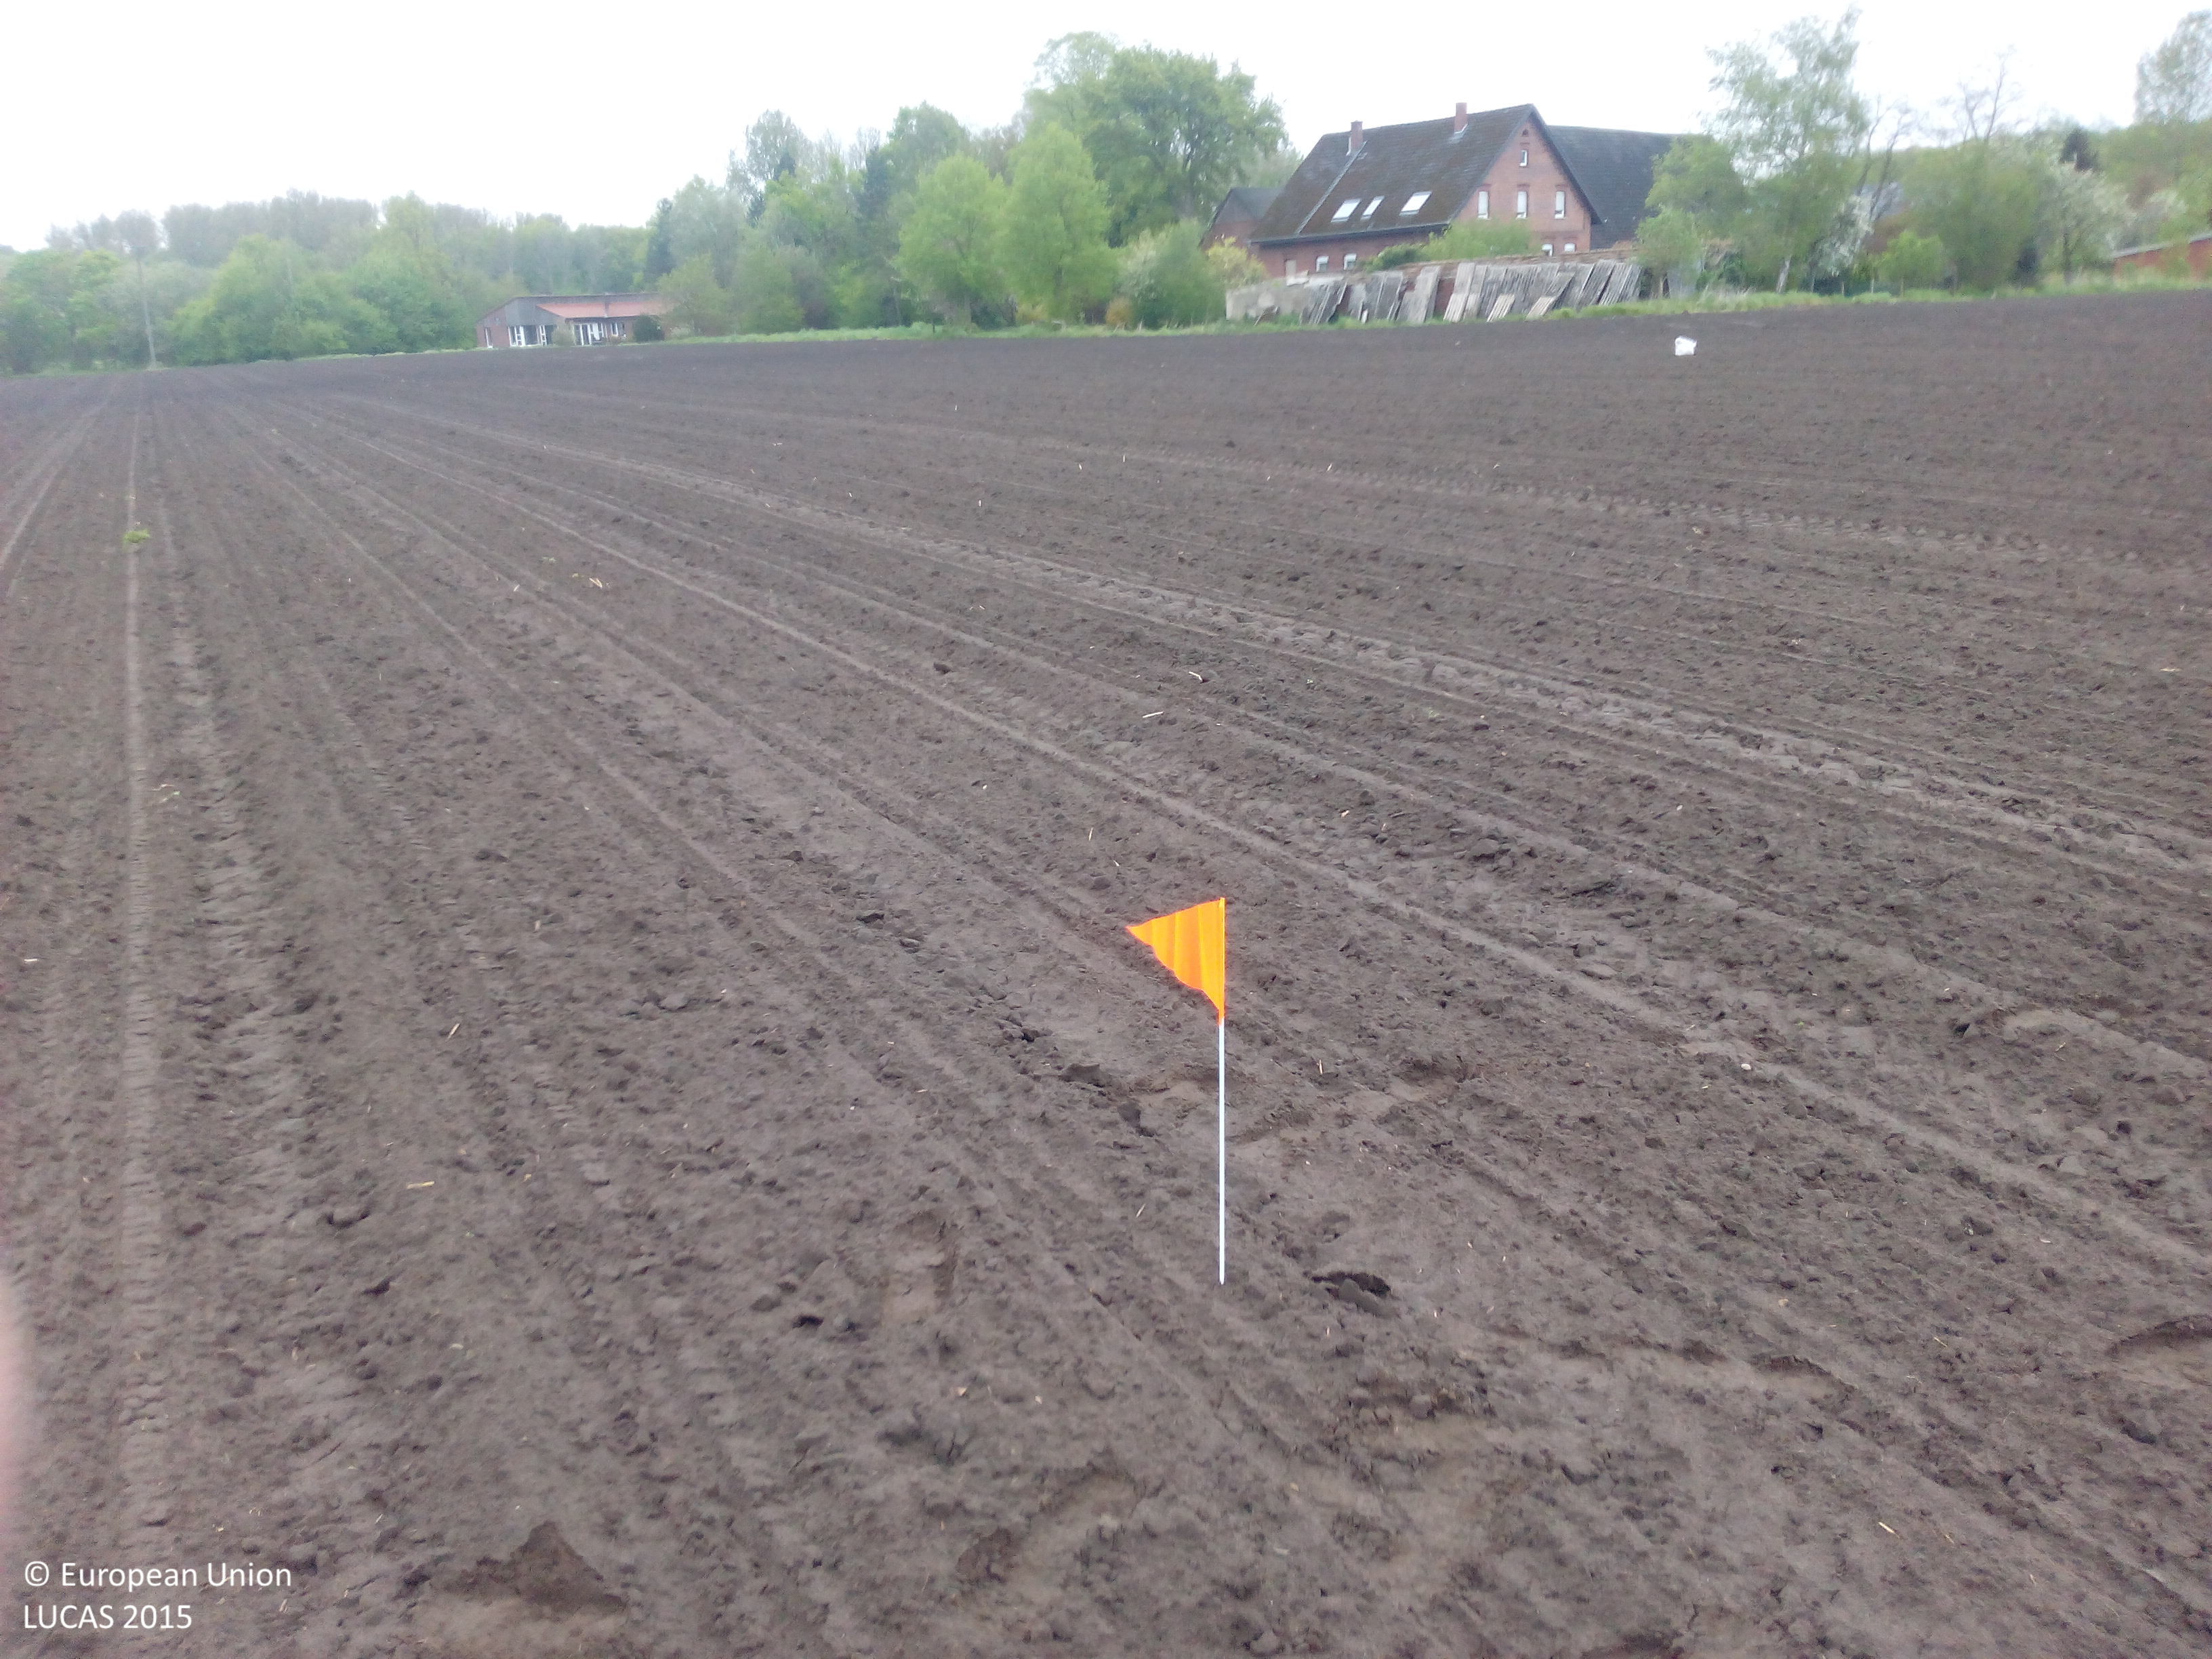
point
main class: Cropland
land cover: Maize
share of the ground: < 10 %
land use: Agriculture (excluding fallow land and kitchen gardens)
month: May
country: DE
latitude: 51.9905
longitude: 7.4518
